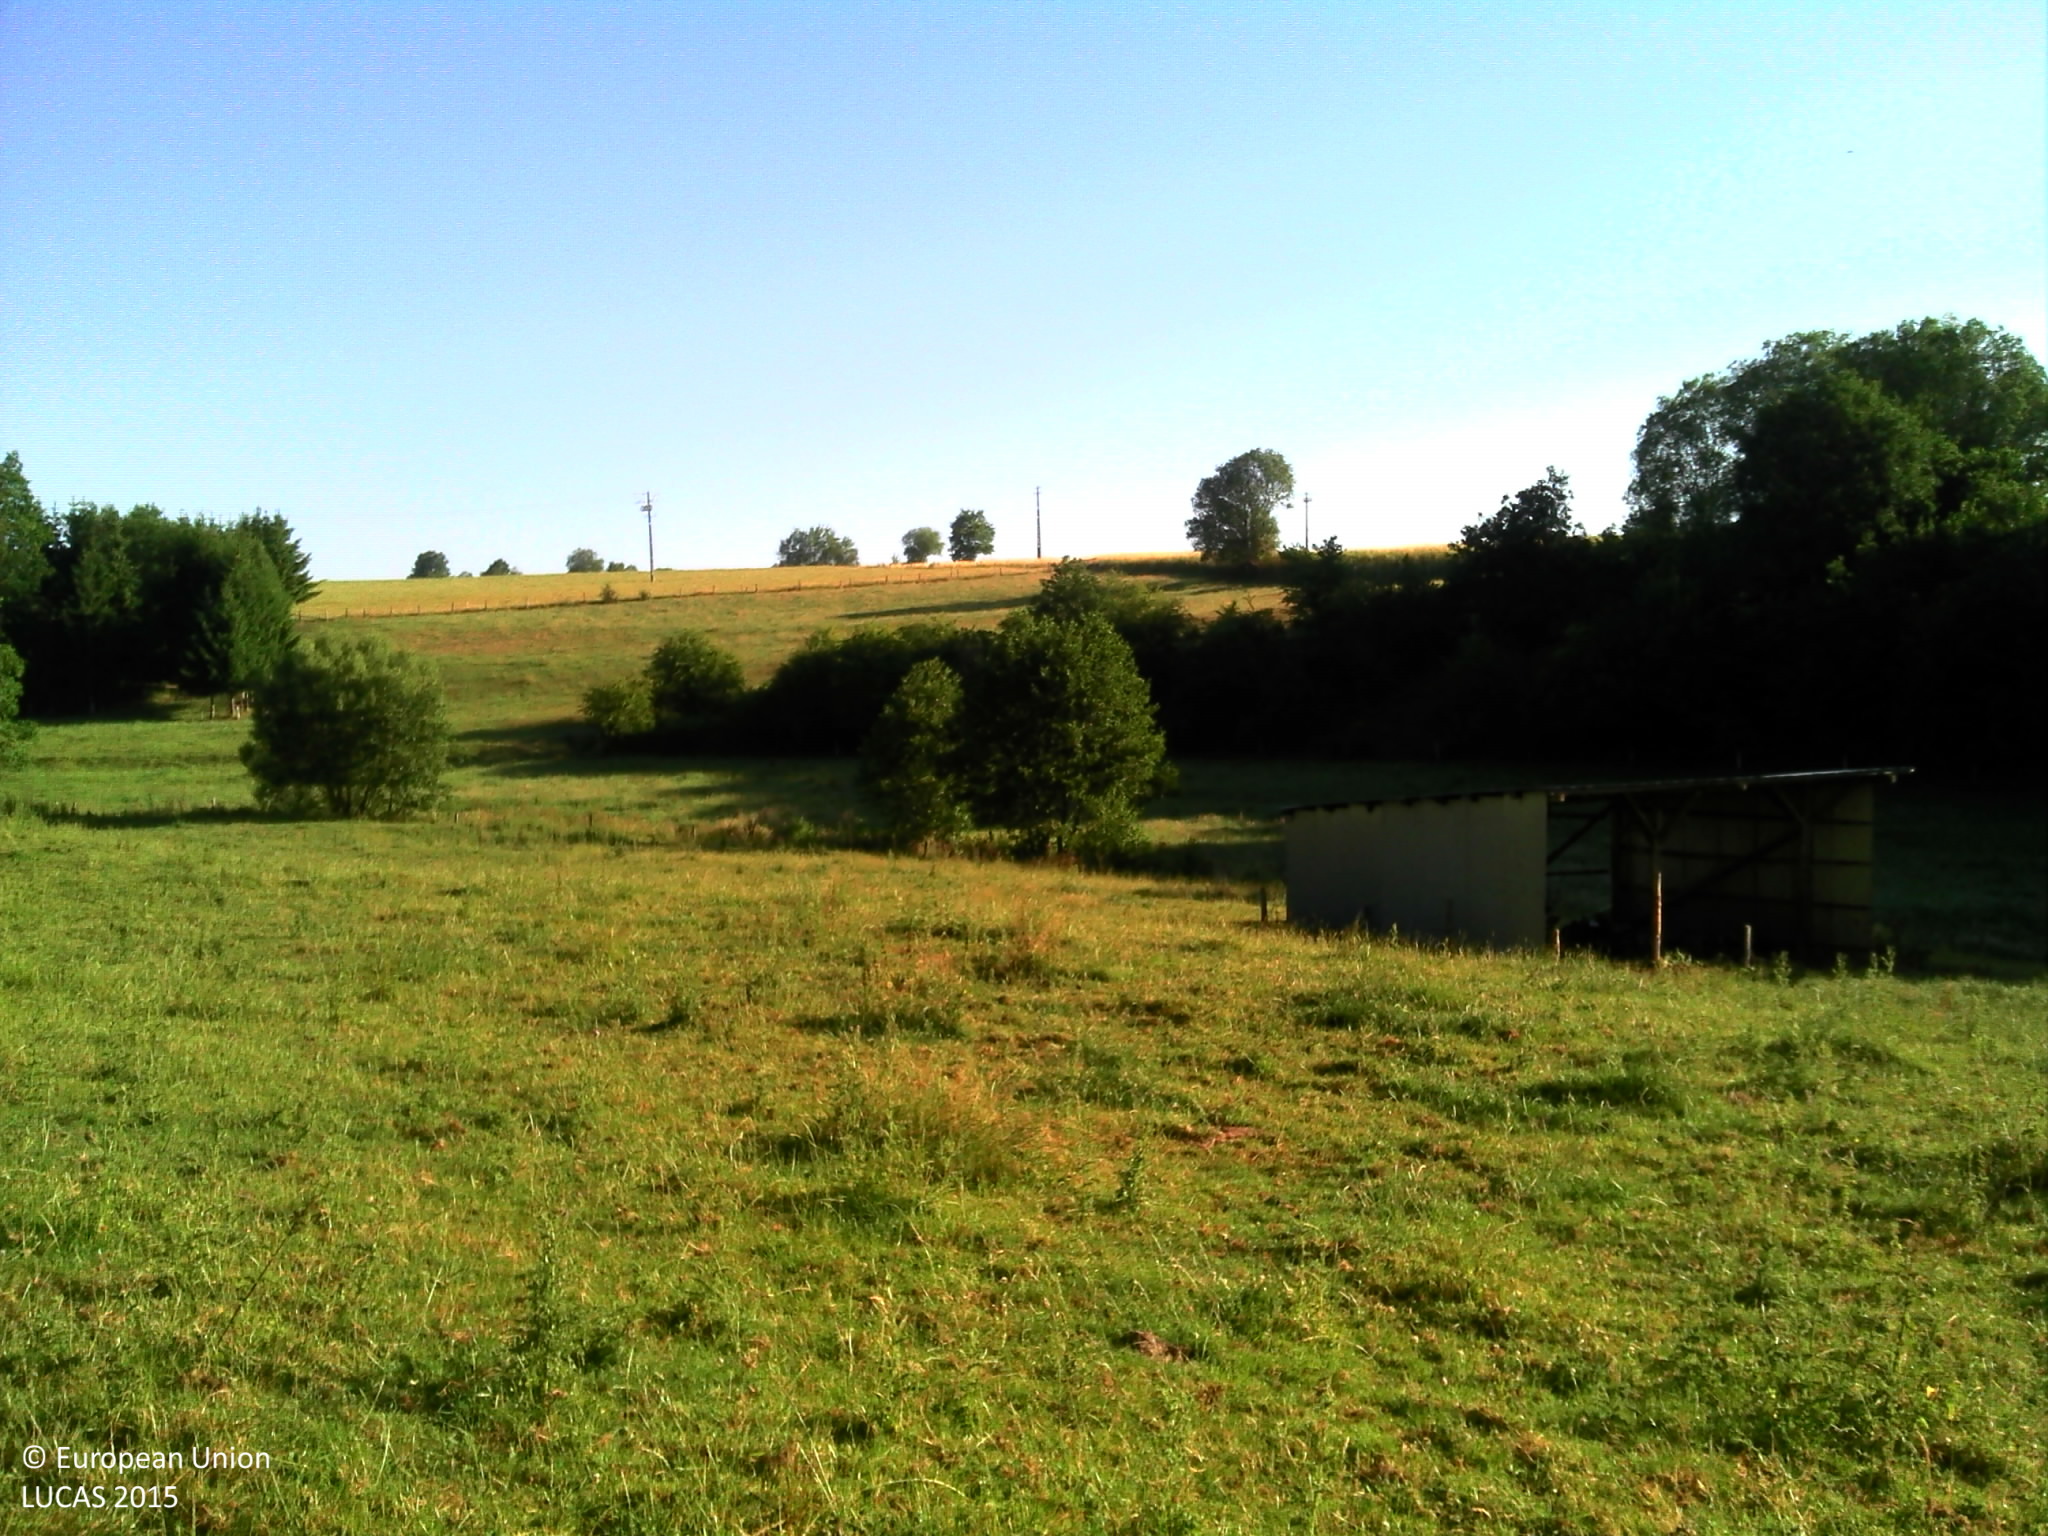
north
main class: Grassland
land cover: Grassland without tree/shrub cover
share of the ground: > 75 %
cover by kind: herbaceous plants 100 %
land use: Agriculture (excluding fallow land and kitchen gardens)
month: July
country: BE
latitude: 50.1182
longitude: 5.6210
